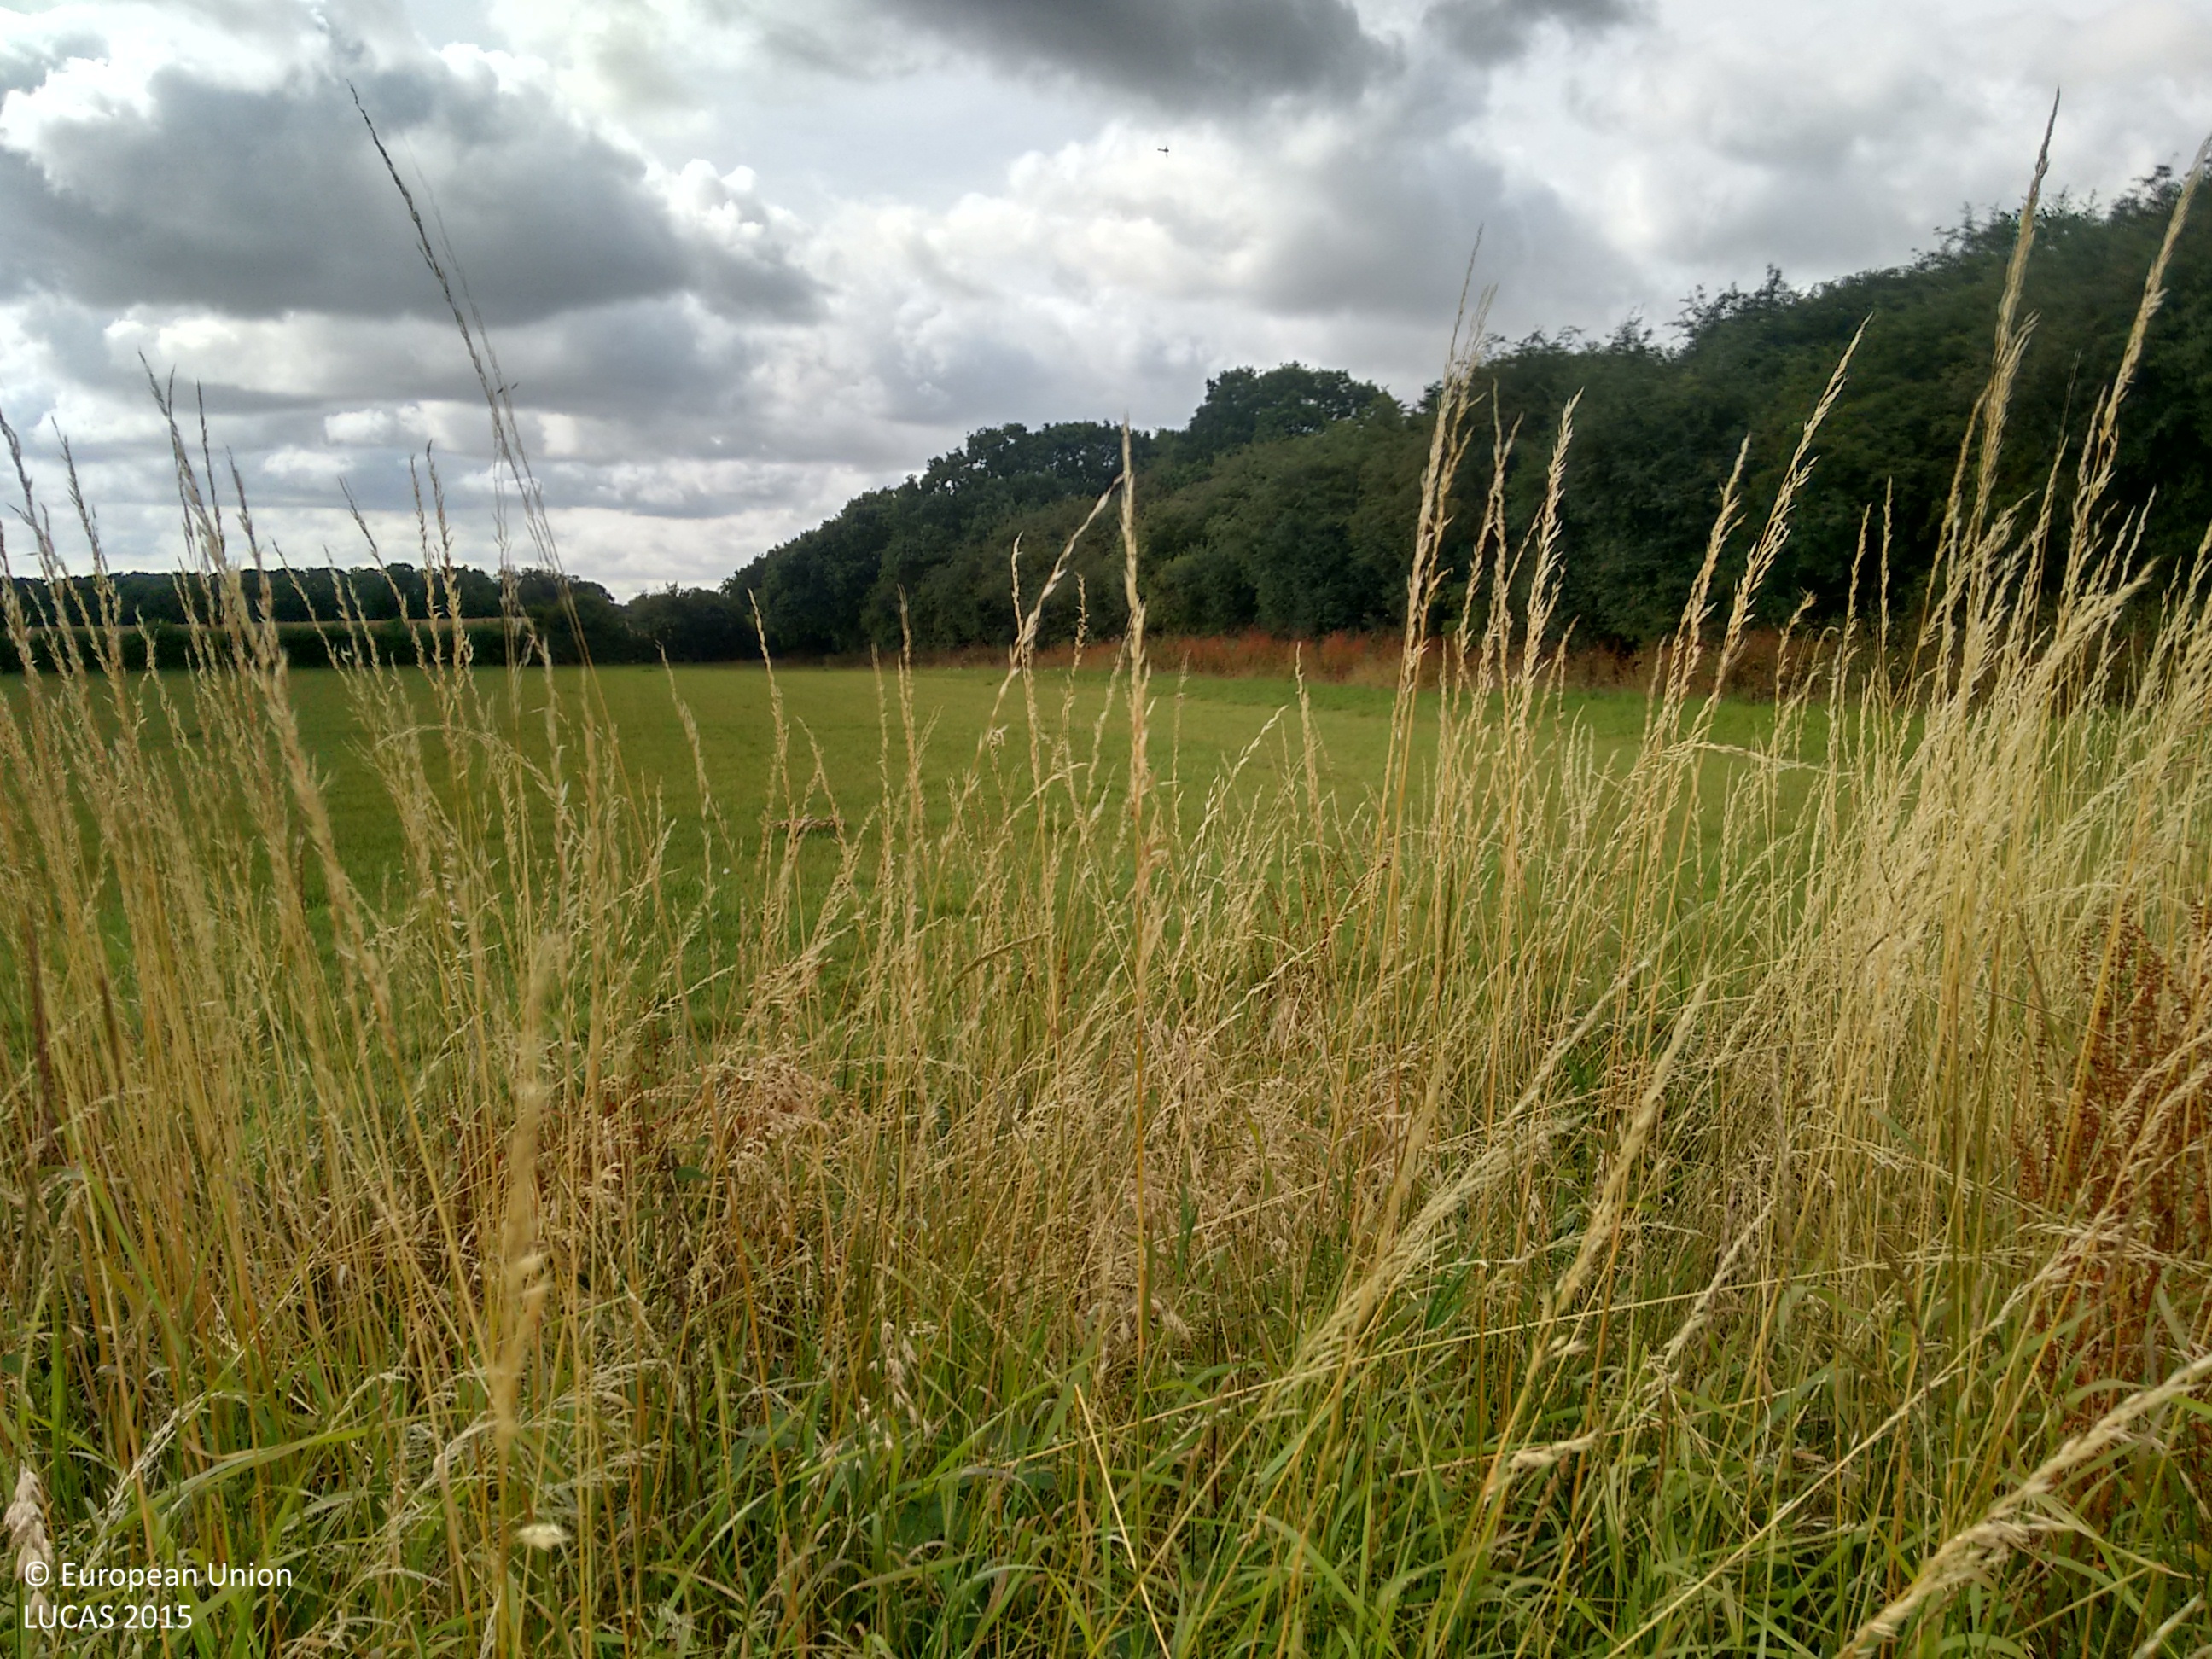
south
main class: Cropland
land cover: Common wheat
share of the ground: > 75 %
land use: Agriculture (excluding fallow land and kitchen gardens)
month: July
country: GB
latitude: 51.6838
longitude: 0.6735
